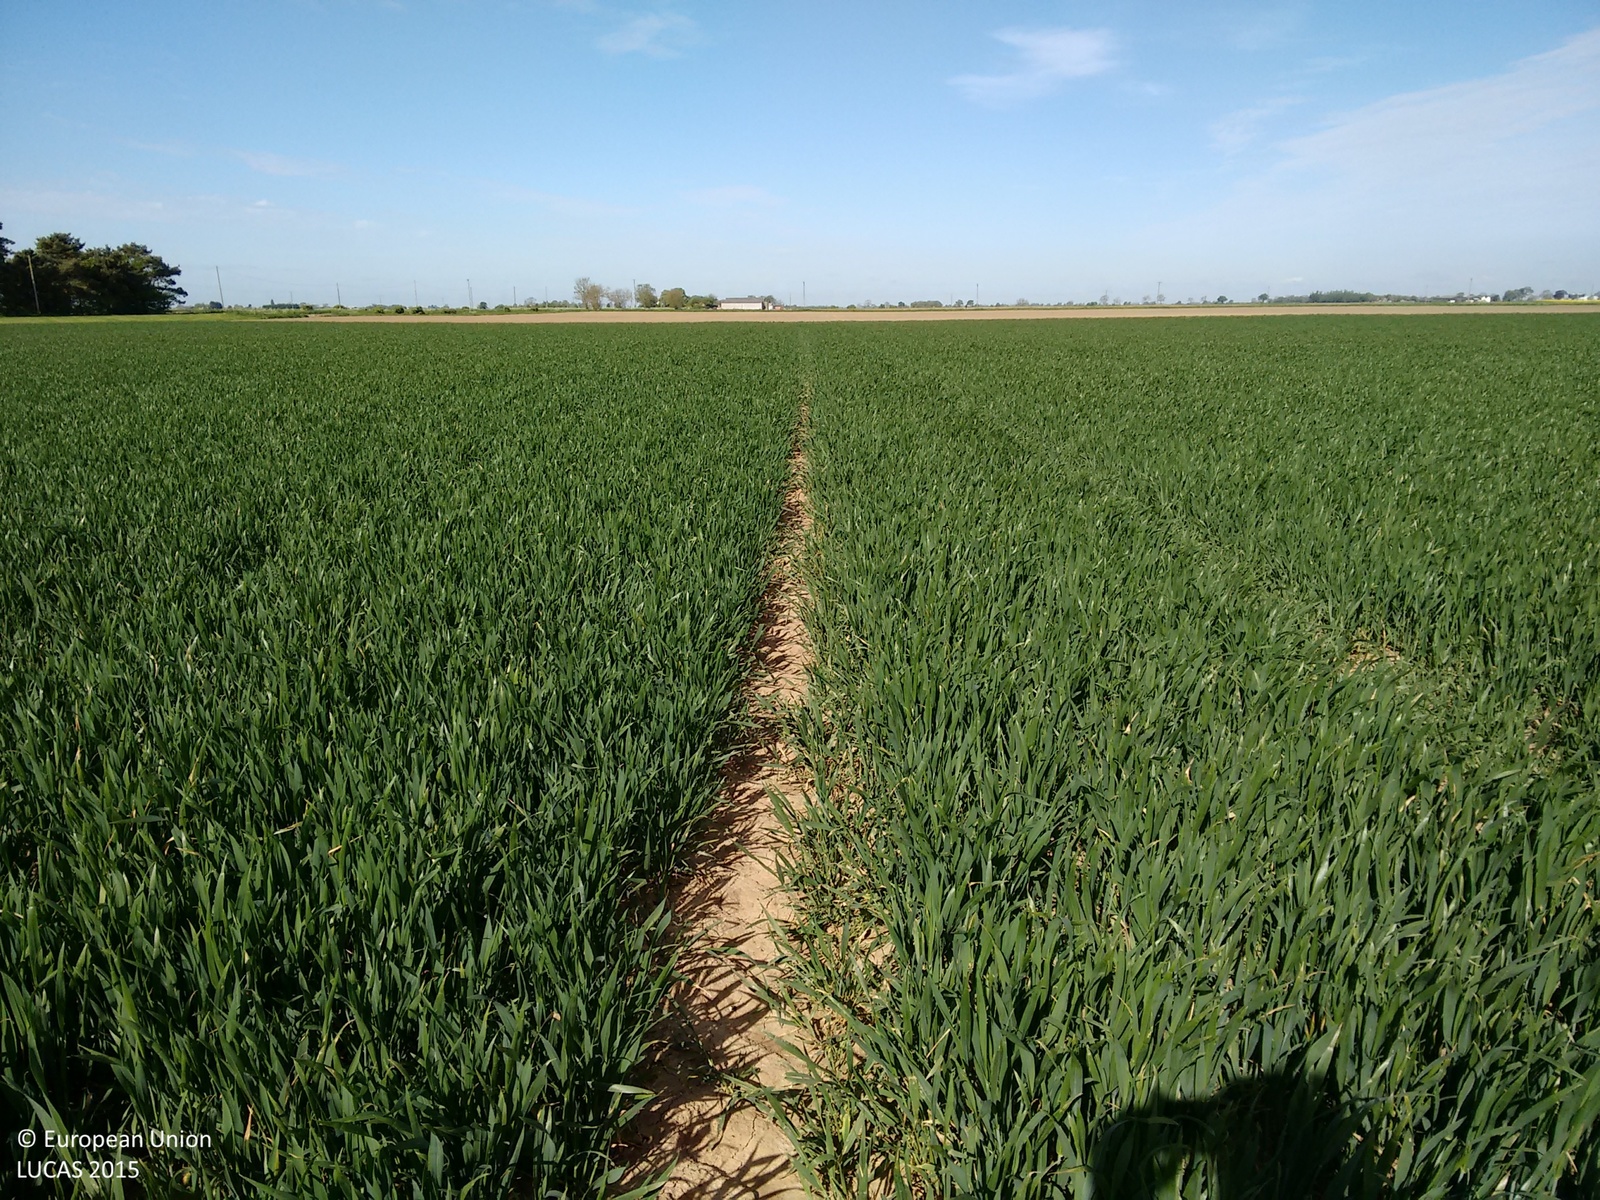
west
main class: Cropland
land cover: Common wheat
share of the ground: > 75 %
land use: Agriculture (excluding fallow land and kitchen gardens)
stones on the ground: < 10 %
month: May
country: GB
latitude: 53.0583
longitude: -0.0142
